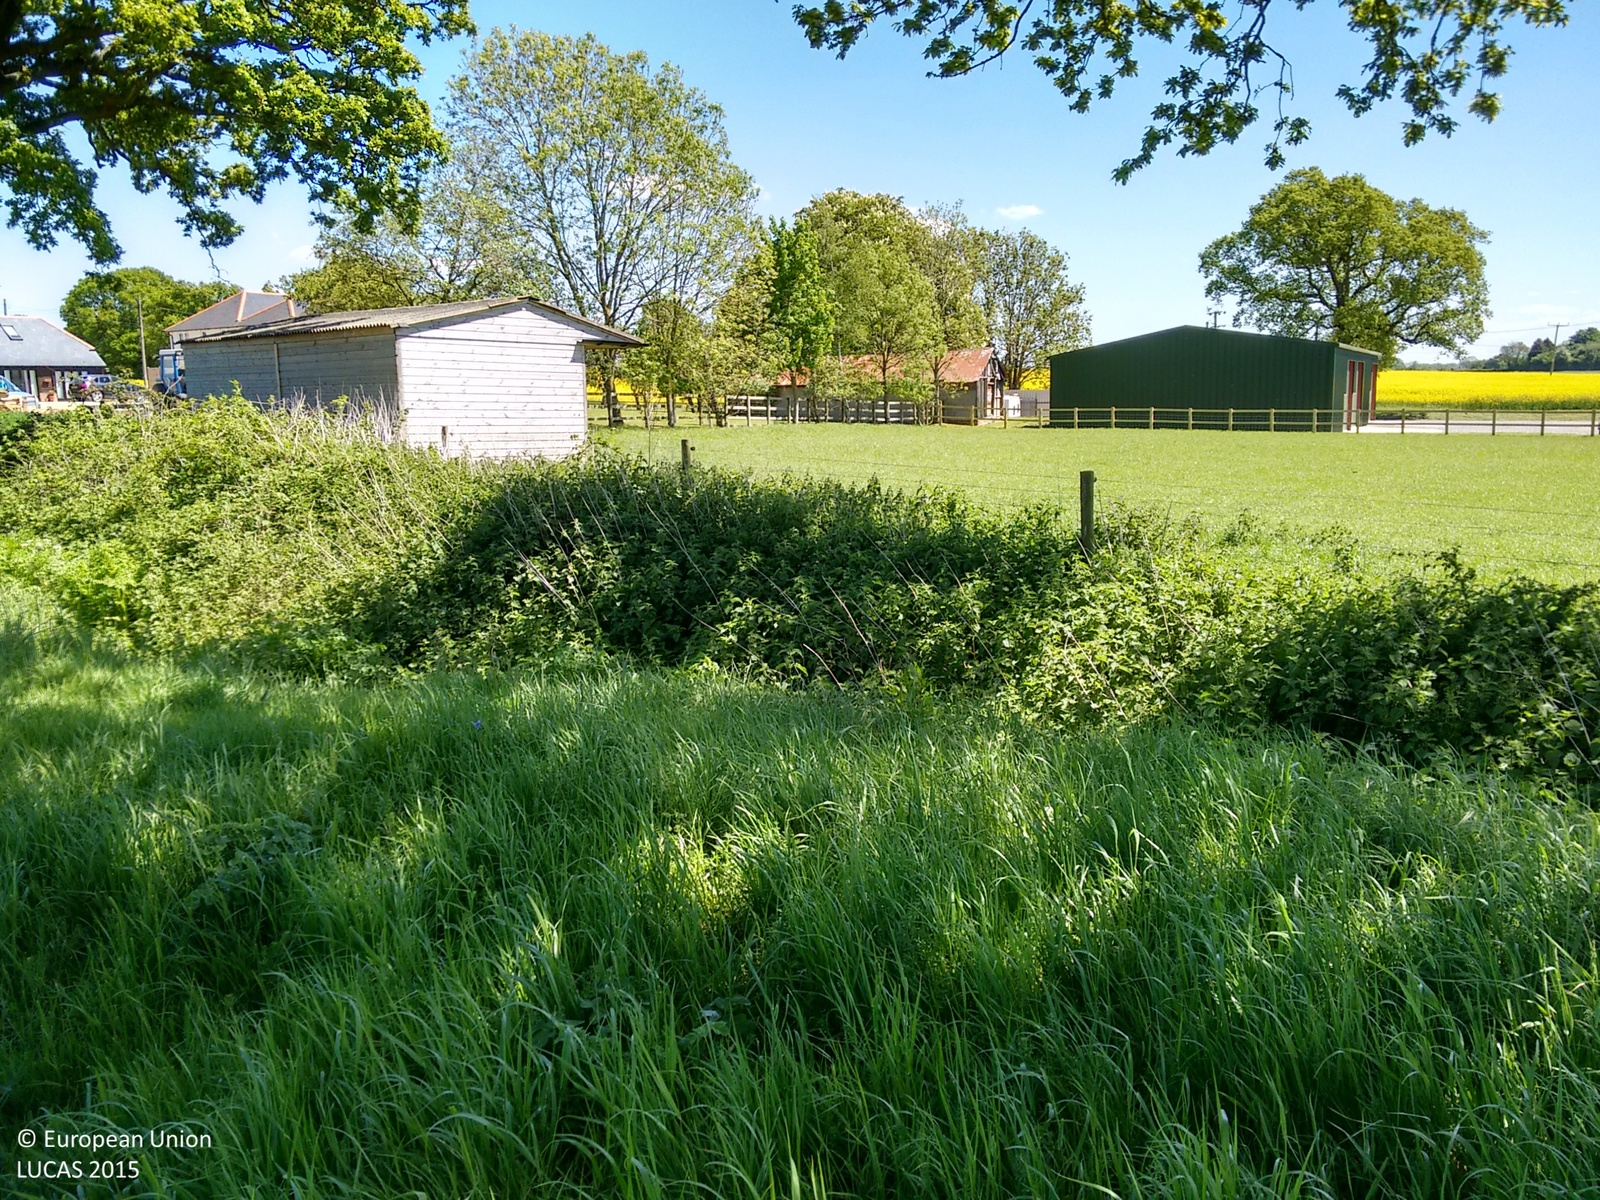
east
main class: Cropland
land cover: Rape and turnip rape
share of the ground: > 75 %
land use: Agriculture (excluding fallow land and kitchen gardens)
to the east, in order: Rape and turnip rape; Grass margins; Artificial constructions in urban areas; Electric lines; Tracks; Grass margins; Rape and turnip rape
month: May
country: GB
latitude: 51.3508
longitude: -1.0582
